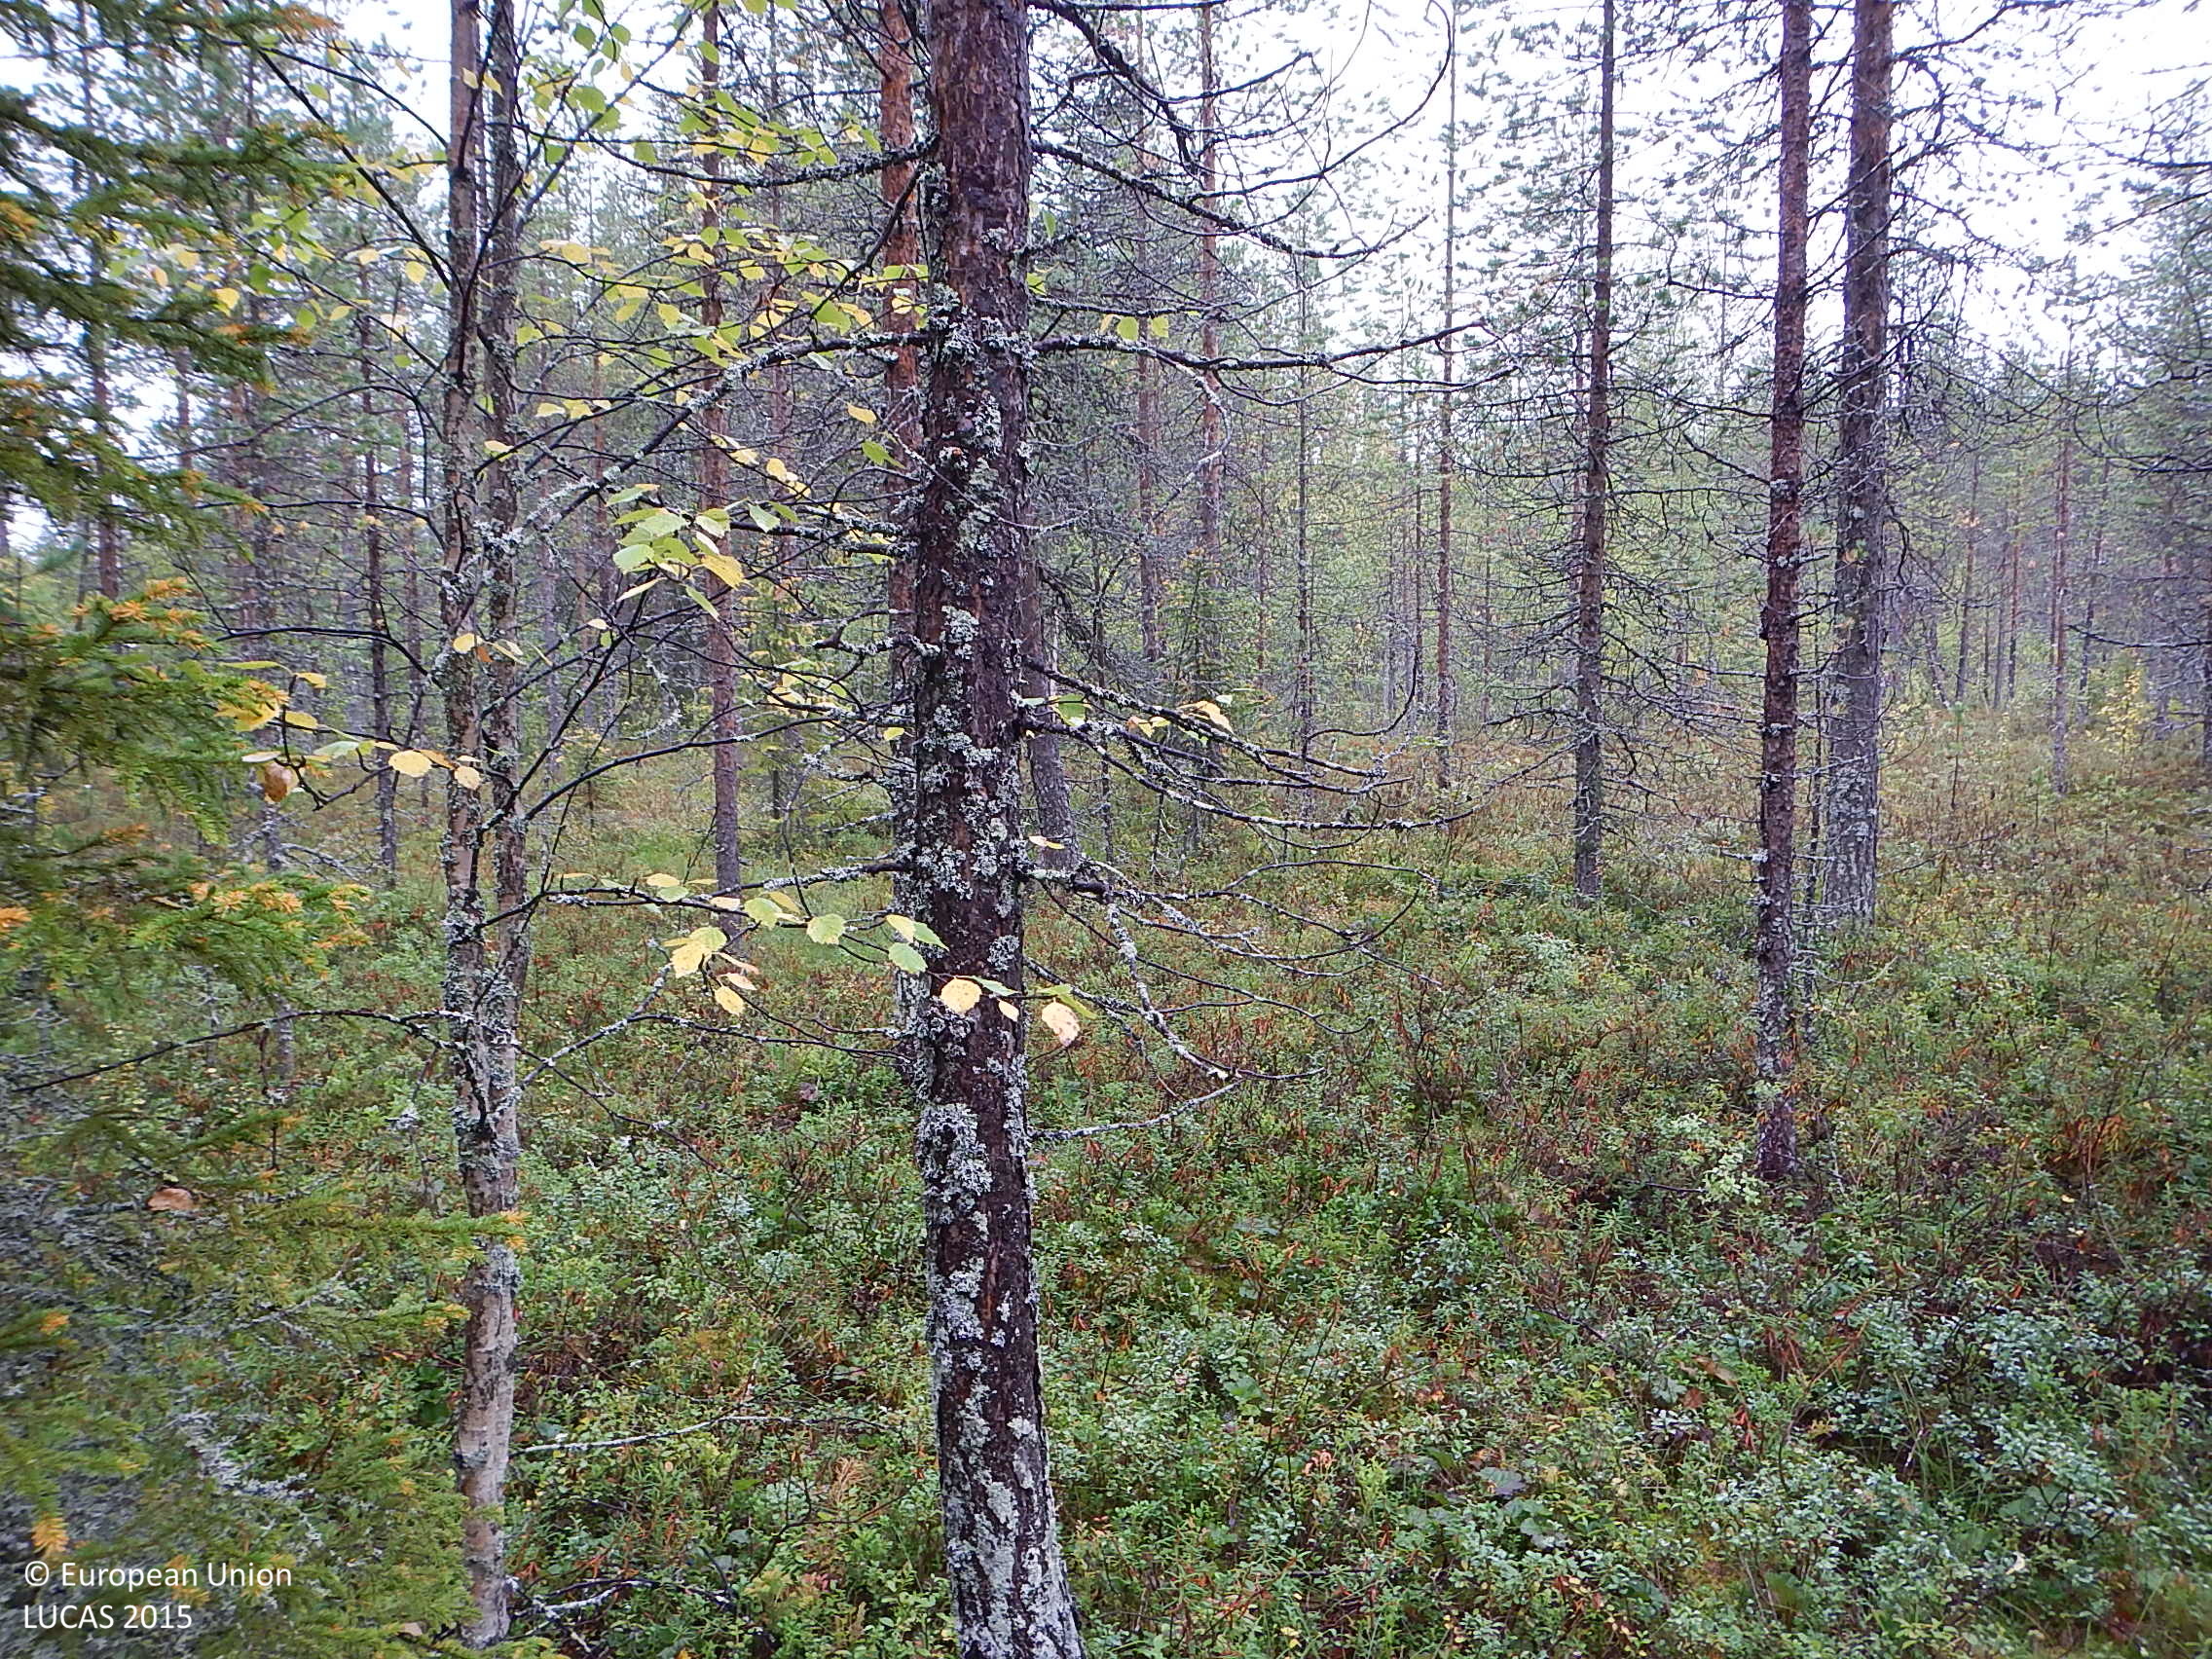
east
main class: Woodland
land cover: Pine dominated coniferous woodland
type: boreal forest
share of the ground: 50 - 75 %
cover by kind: coniferous forest trees 60 %, shrubs 20 %, broadleaved forest trees 10 %, herbaceous plants 10 %
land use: Forestry
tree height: > 5 m
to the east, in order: Pine dominated coniferous woodland; Abandoned hedges; Ditches and canals; Abandoned hedges; Pine dominated coniferous woodland; Pine dominated mixed woodland
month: August
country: FI
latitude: 65.9762
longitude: 27.3994
